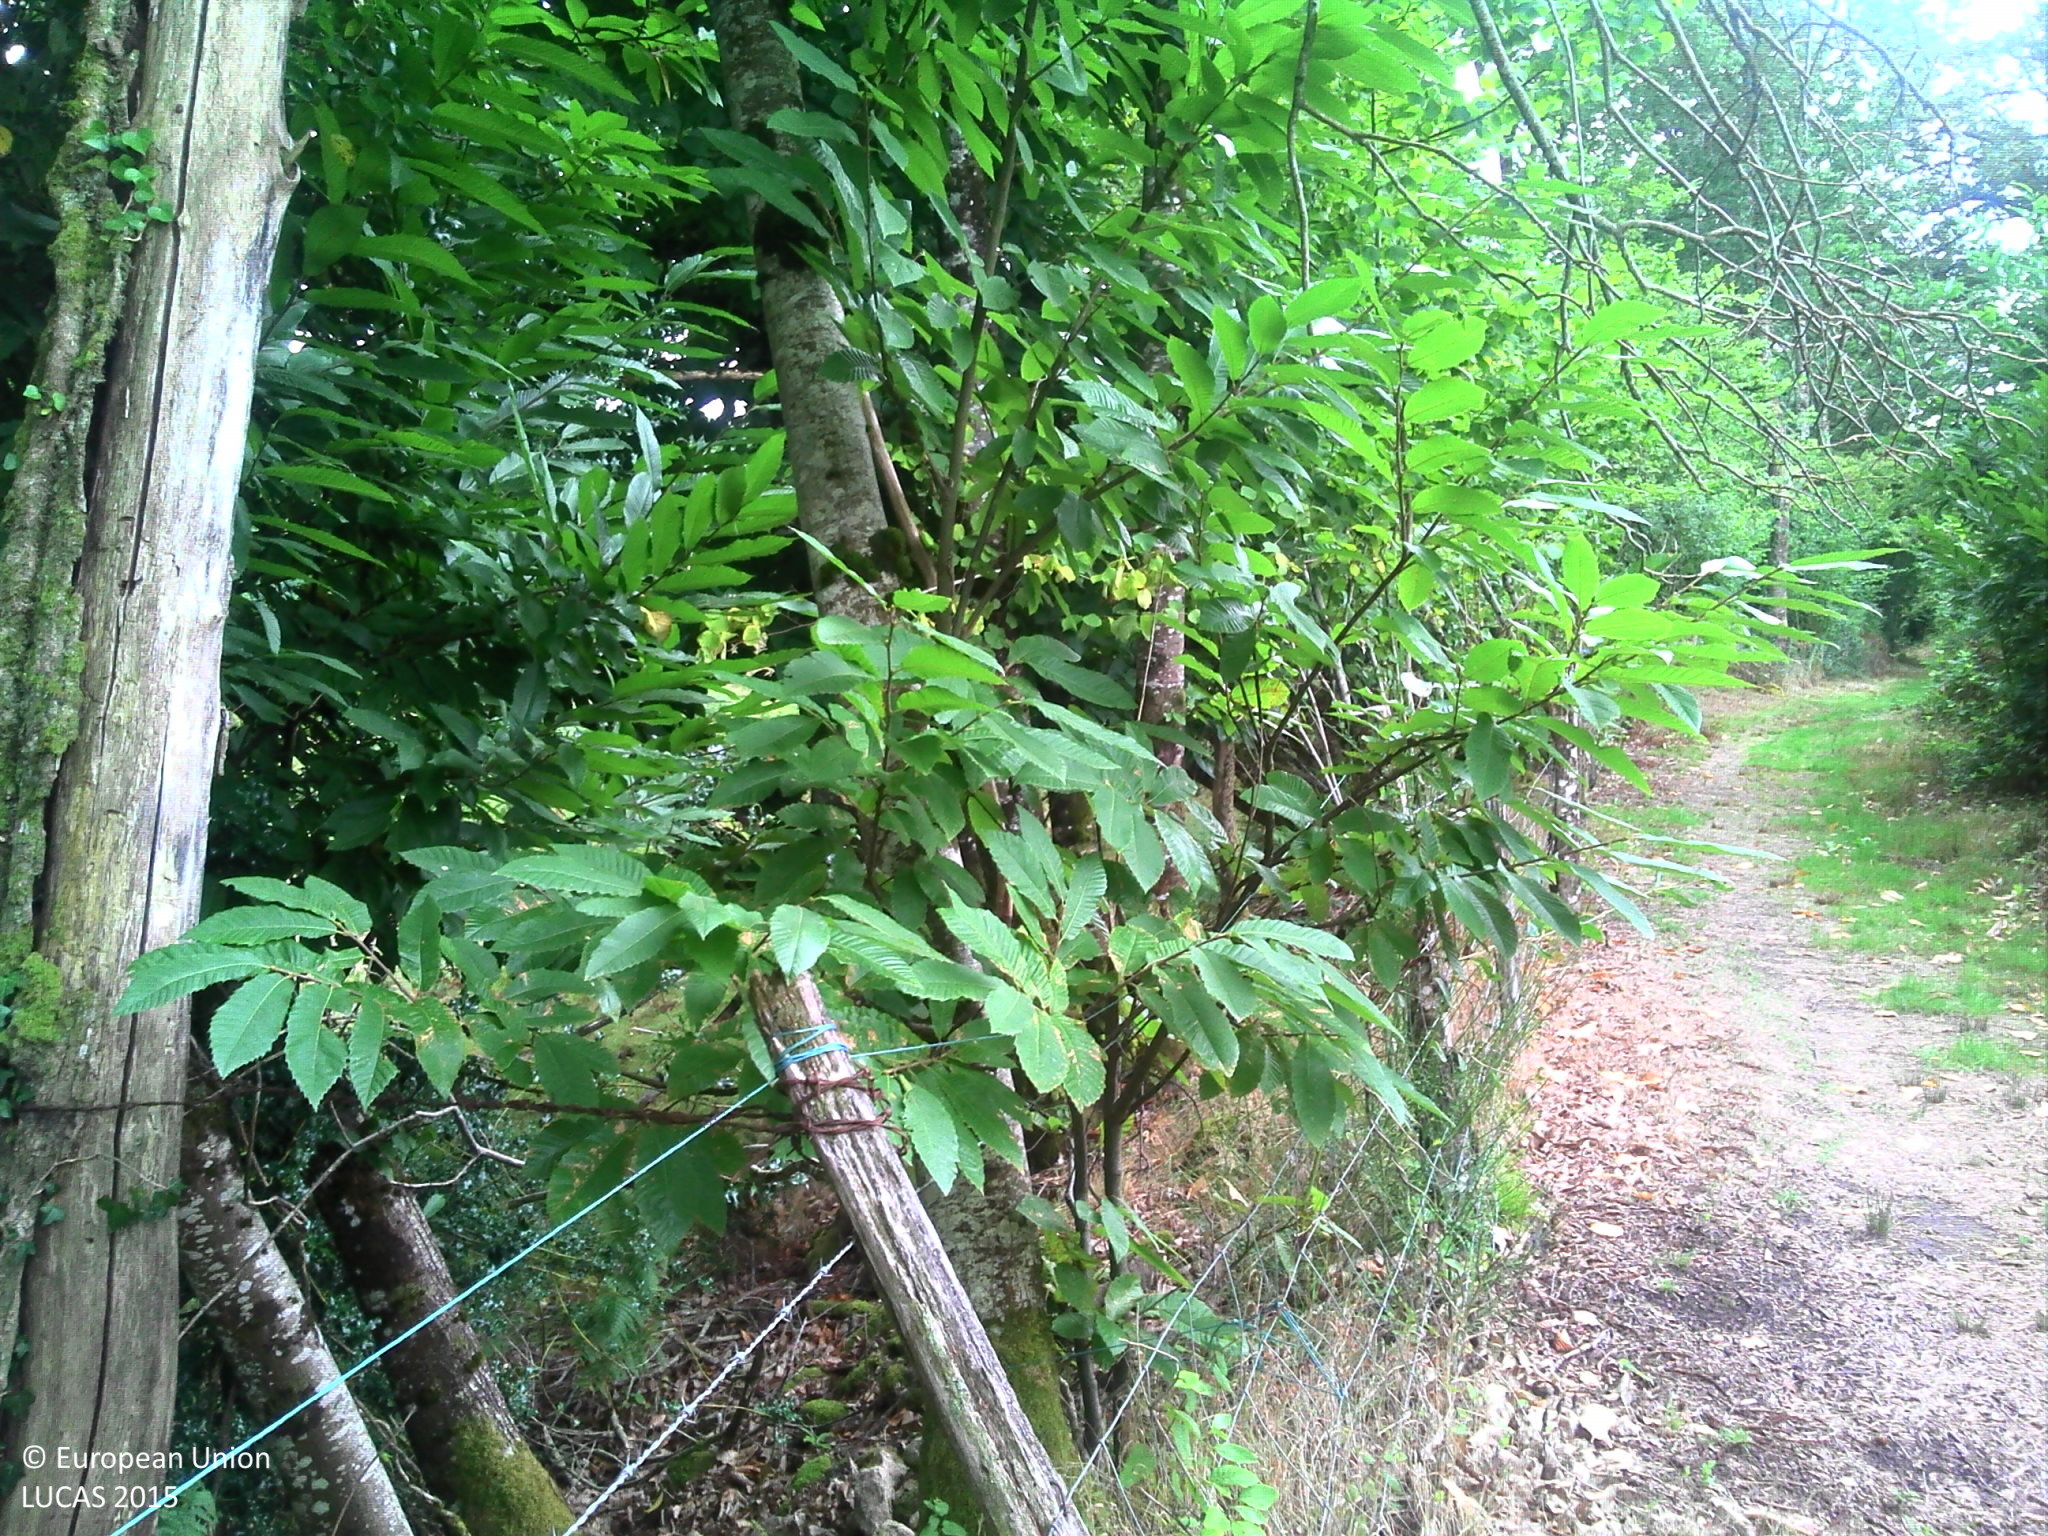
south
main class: Grassland
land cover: Grassland without tree/shrub cover
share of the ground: > 75 %
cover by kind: herbaceous plants 100 %
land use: Agriculture (excluding fallow land and kitchen gardens)
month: August
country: FR
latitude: 46.0220
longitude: 0.9586
